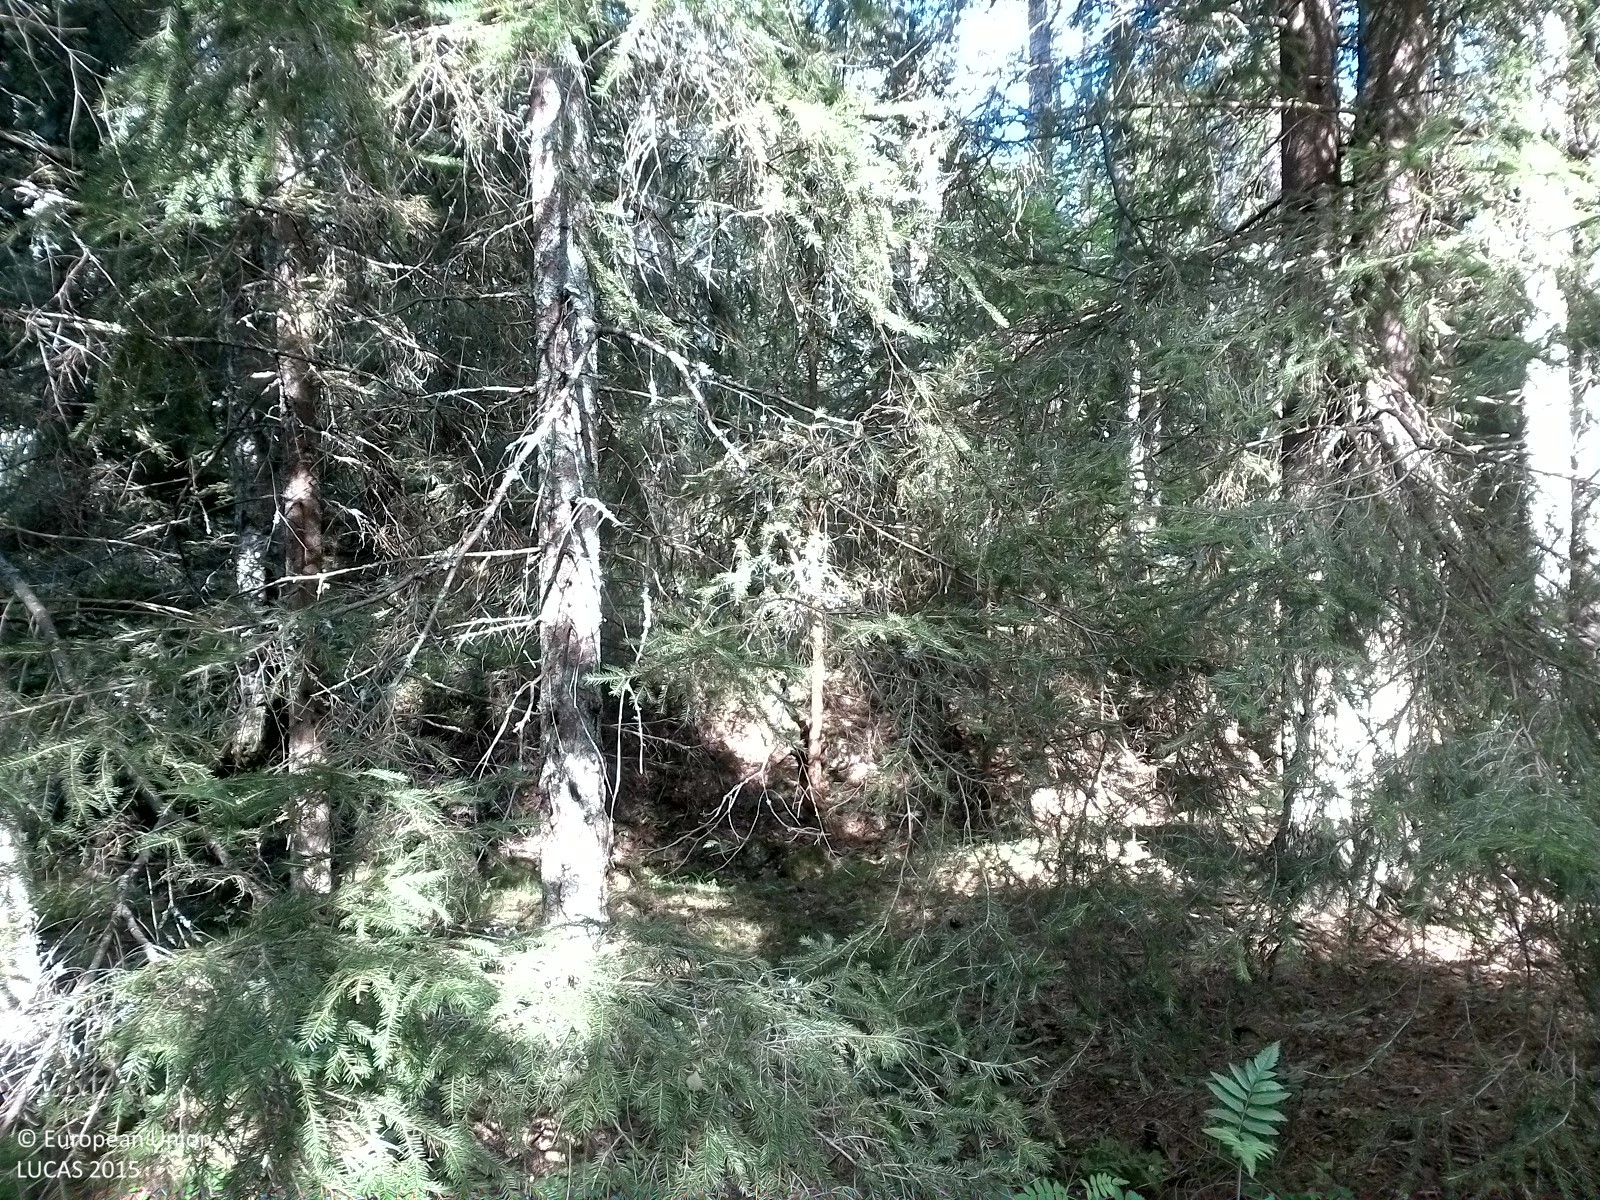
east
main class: Woodland
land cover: Other mixed woodland
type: boreal forest
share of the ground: 50 - 75 %
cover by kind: coniferous forest trees 35 %, lichens and mosses 30 %, broadleaved forest trees 20 %, herbaceous plants 15 %
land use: Forestry
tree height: > 5 m
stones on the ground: < 10 %
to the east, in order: Other mixed woodland; Tracks; Pine dominated mixed woodland; Grassland without tree/shrub cover; Artificial constructions in urban areas; Grassland without tree/shrub cover
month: August
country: SE
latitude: 59.2175
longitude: 14.7391
